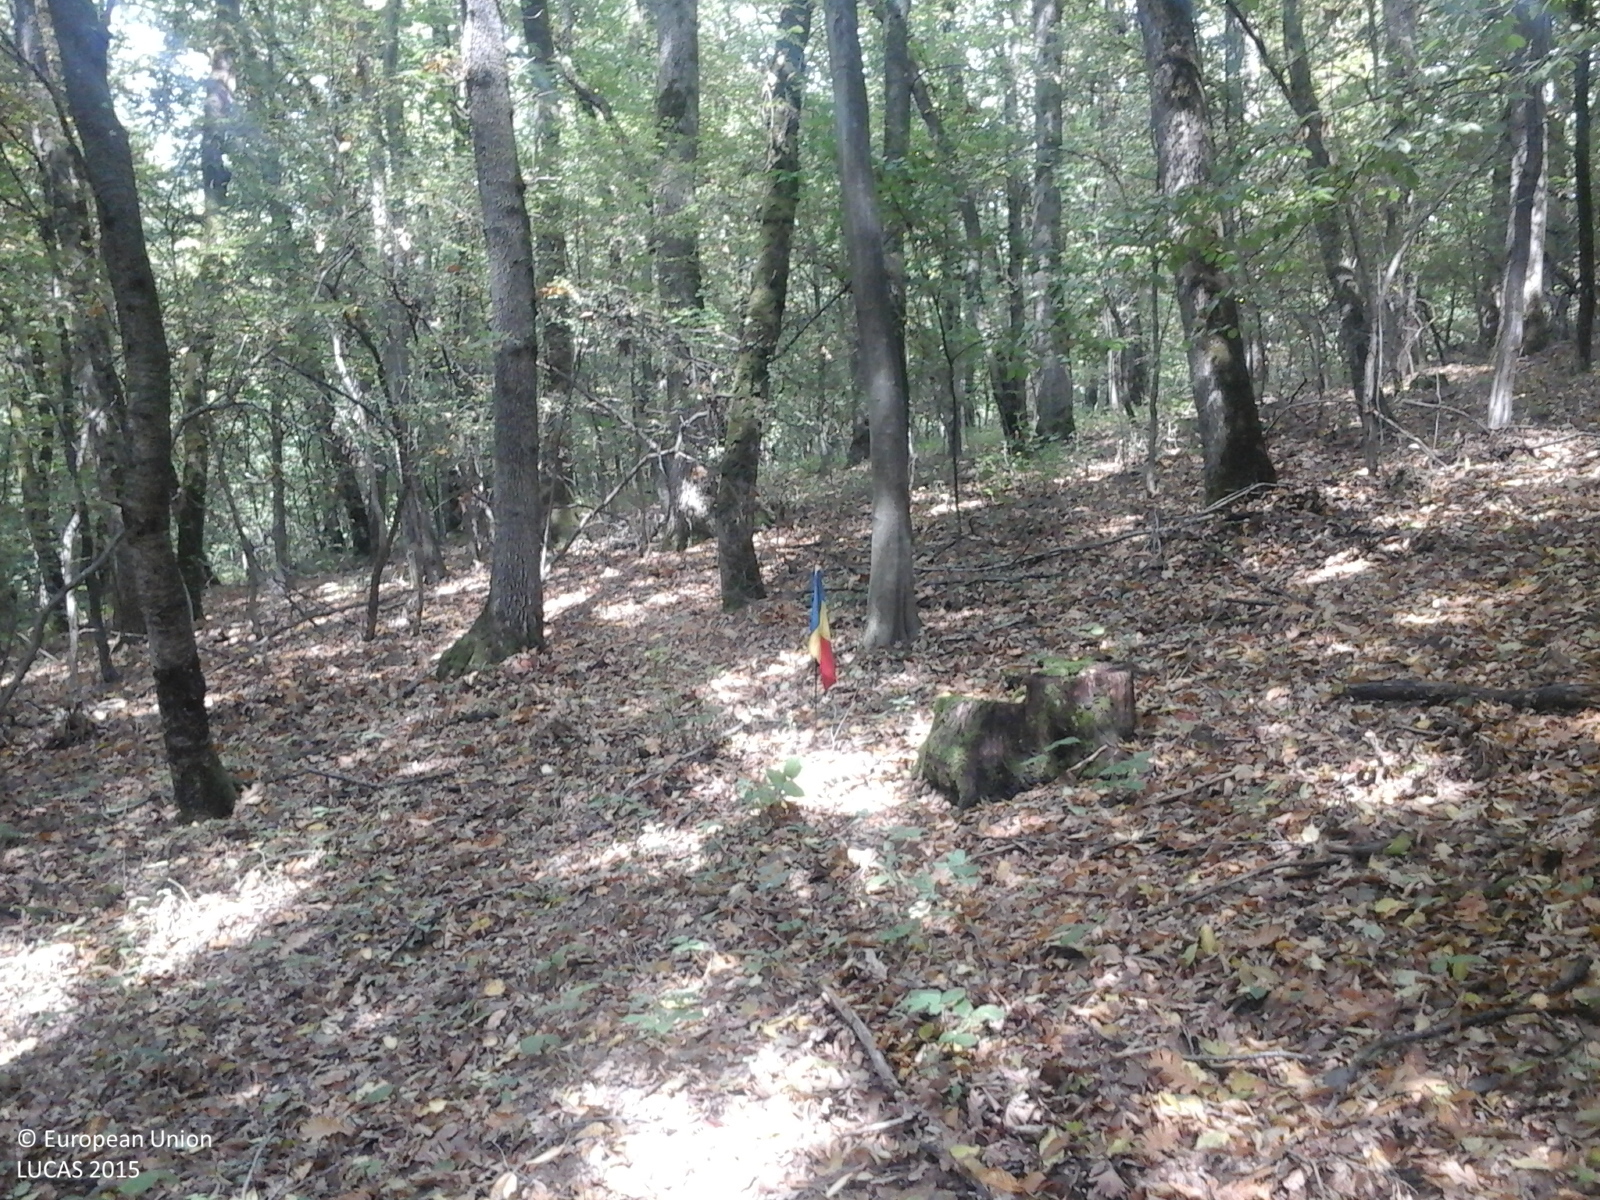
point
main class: Woodland
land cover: Broadleaved woodland
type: beech forest
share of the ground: > 75 %
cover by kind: broadleaved forest trees 100 %
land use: Forestry
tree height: > 5 m
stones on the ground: 10 - 25 %
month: August
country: RO
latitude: 45.2911
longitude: 21.6744
